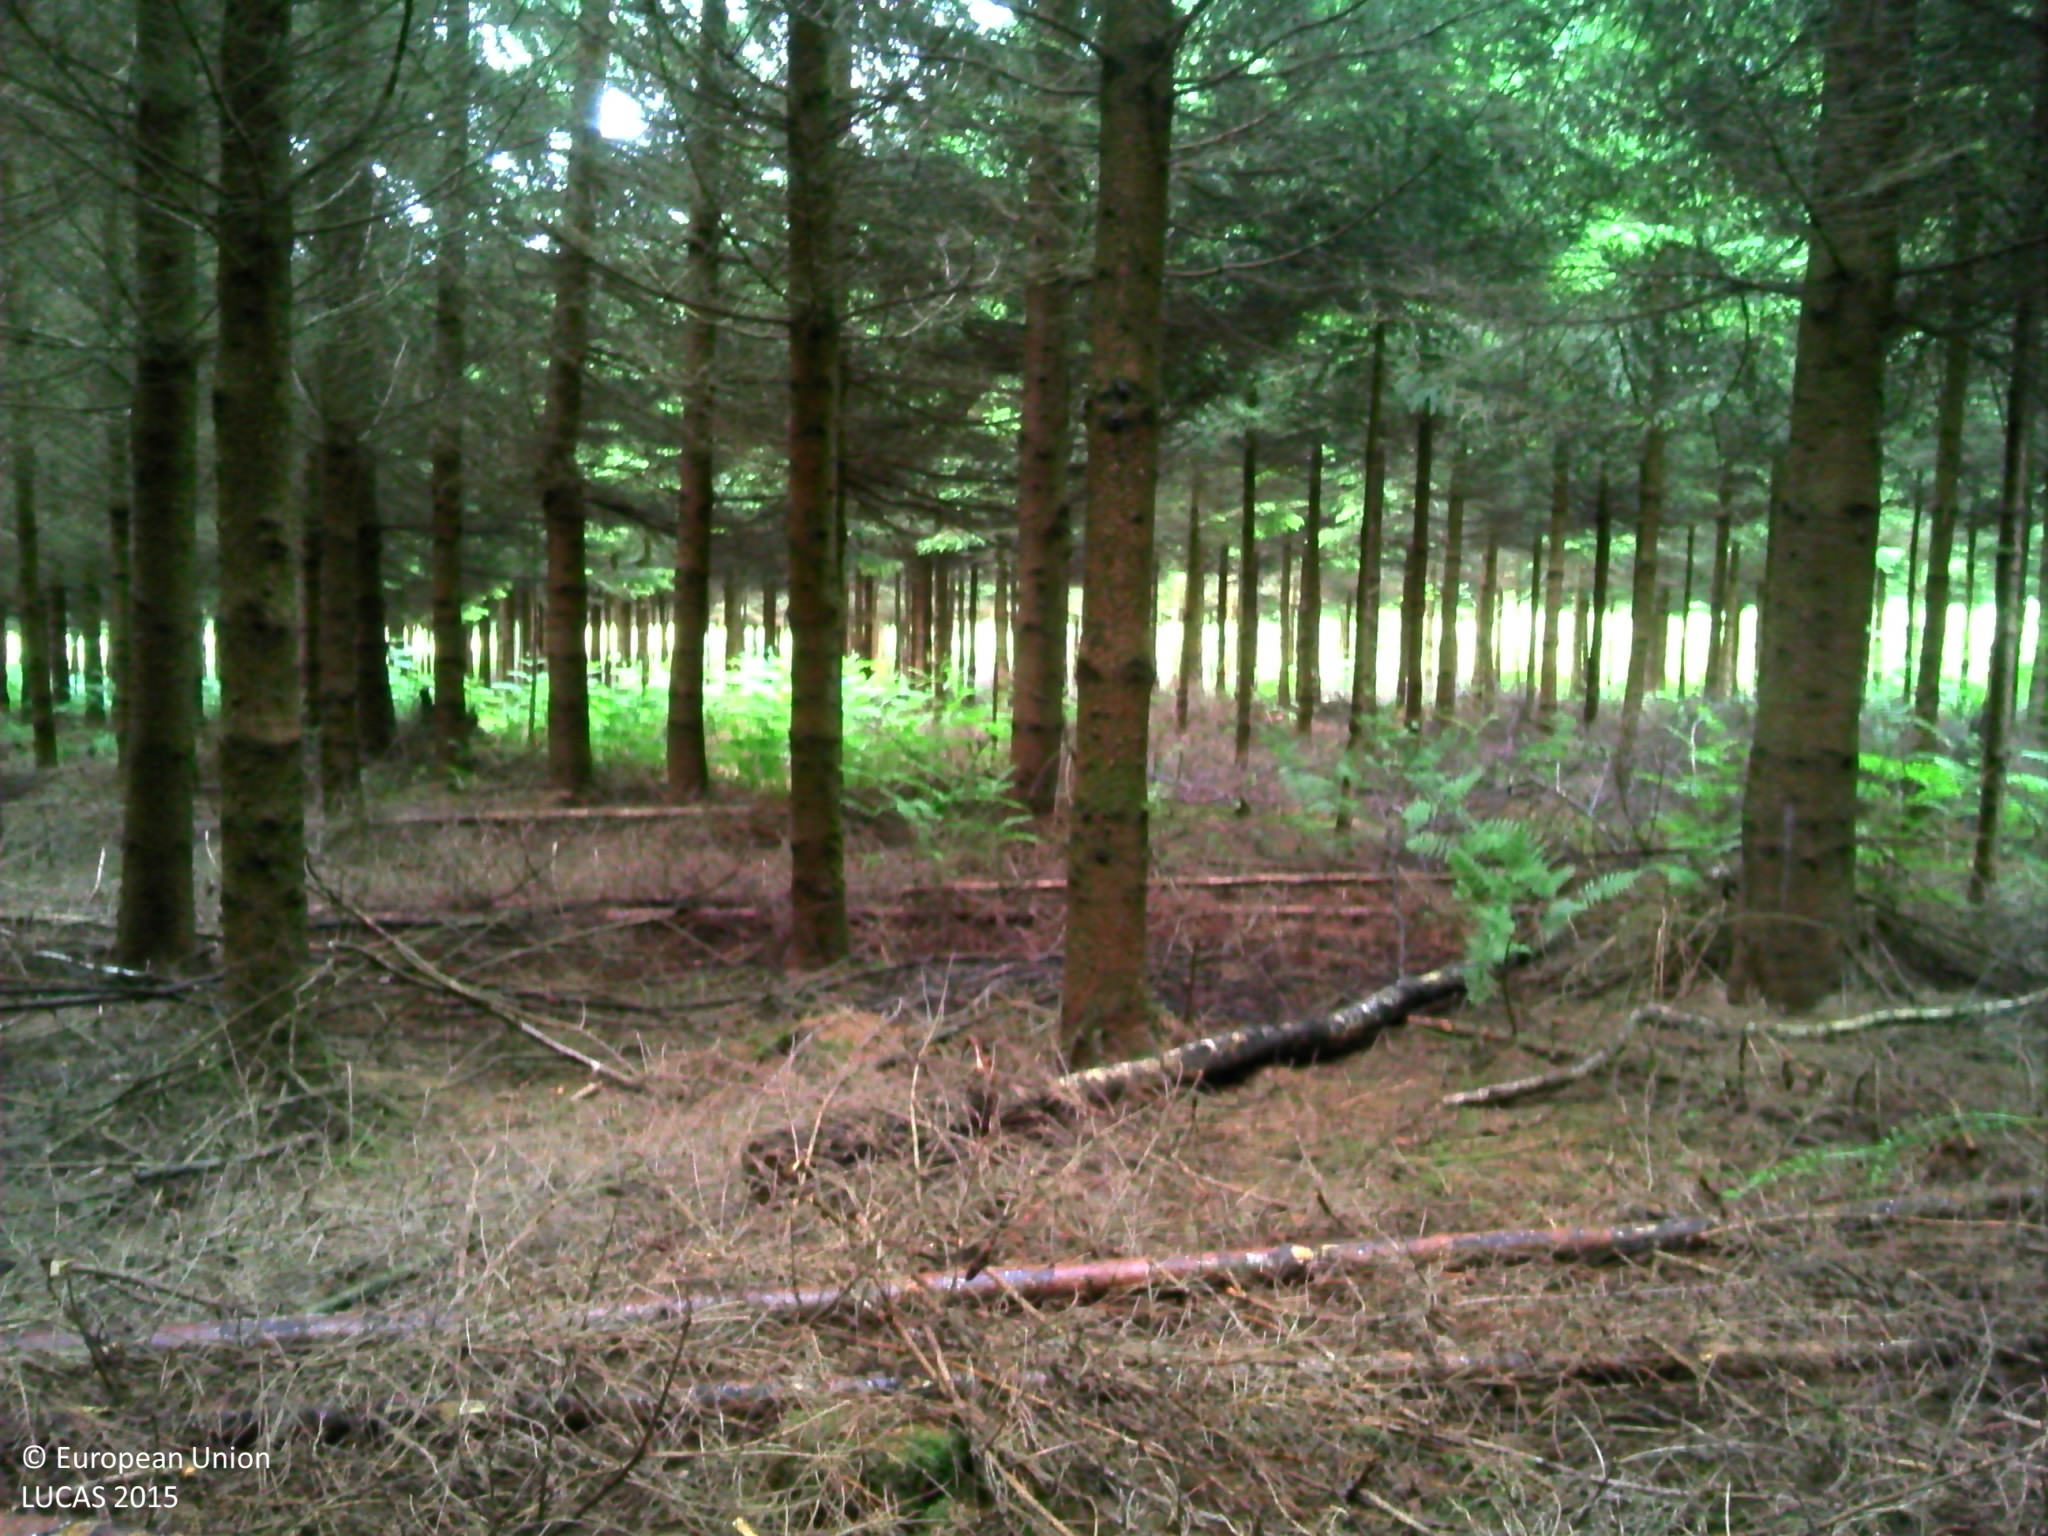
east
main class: Woodland
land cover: Spruce dominated coniferous woodland
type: alpine coniferous forest
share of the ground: > 75 %
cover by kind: coniferous forest trees 95 %, unconsolidated bare surface 5 %
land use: Forestry
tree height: > 5 m
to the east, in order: Spruce dominated coniferous woodland; Spontaneously vegetated surfaces; Fences; Grassland without tree/shrub cover; Fences; Grass margins; Tracks; Grass margins; Spruce dominated coniferous woodland
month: July
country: BE
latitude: 50.0896
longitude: 5.8197
